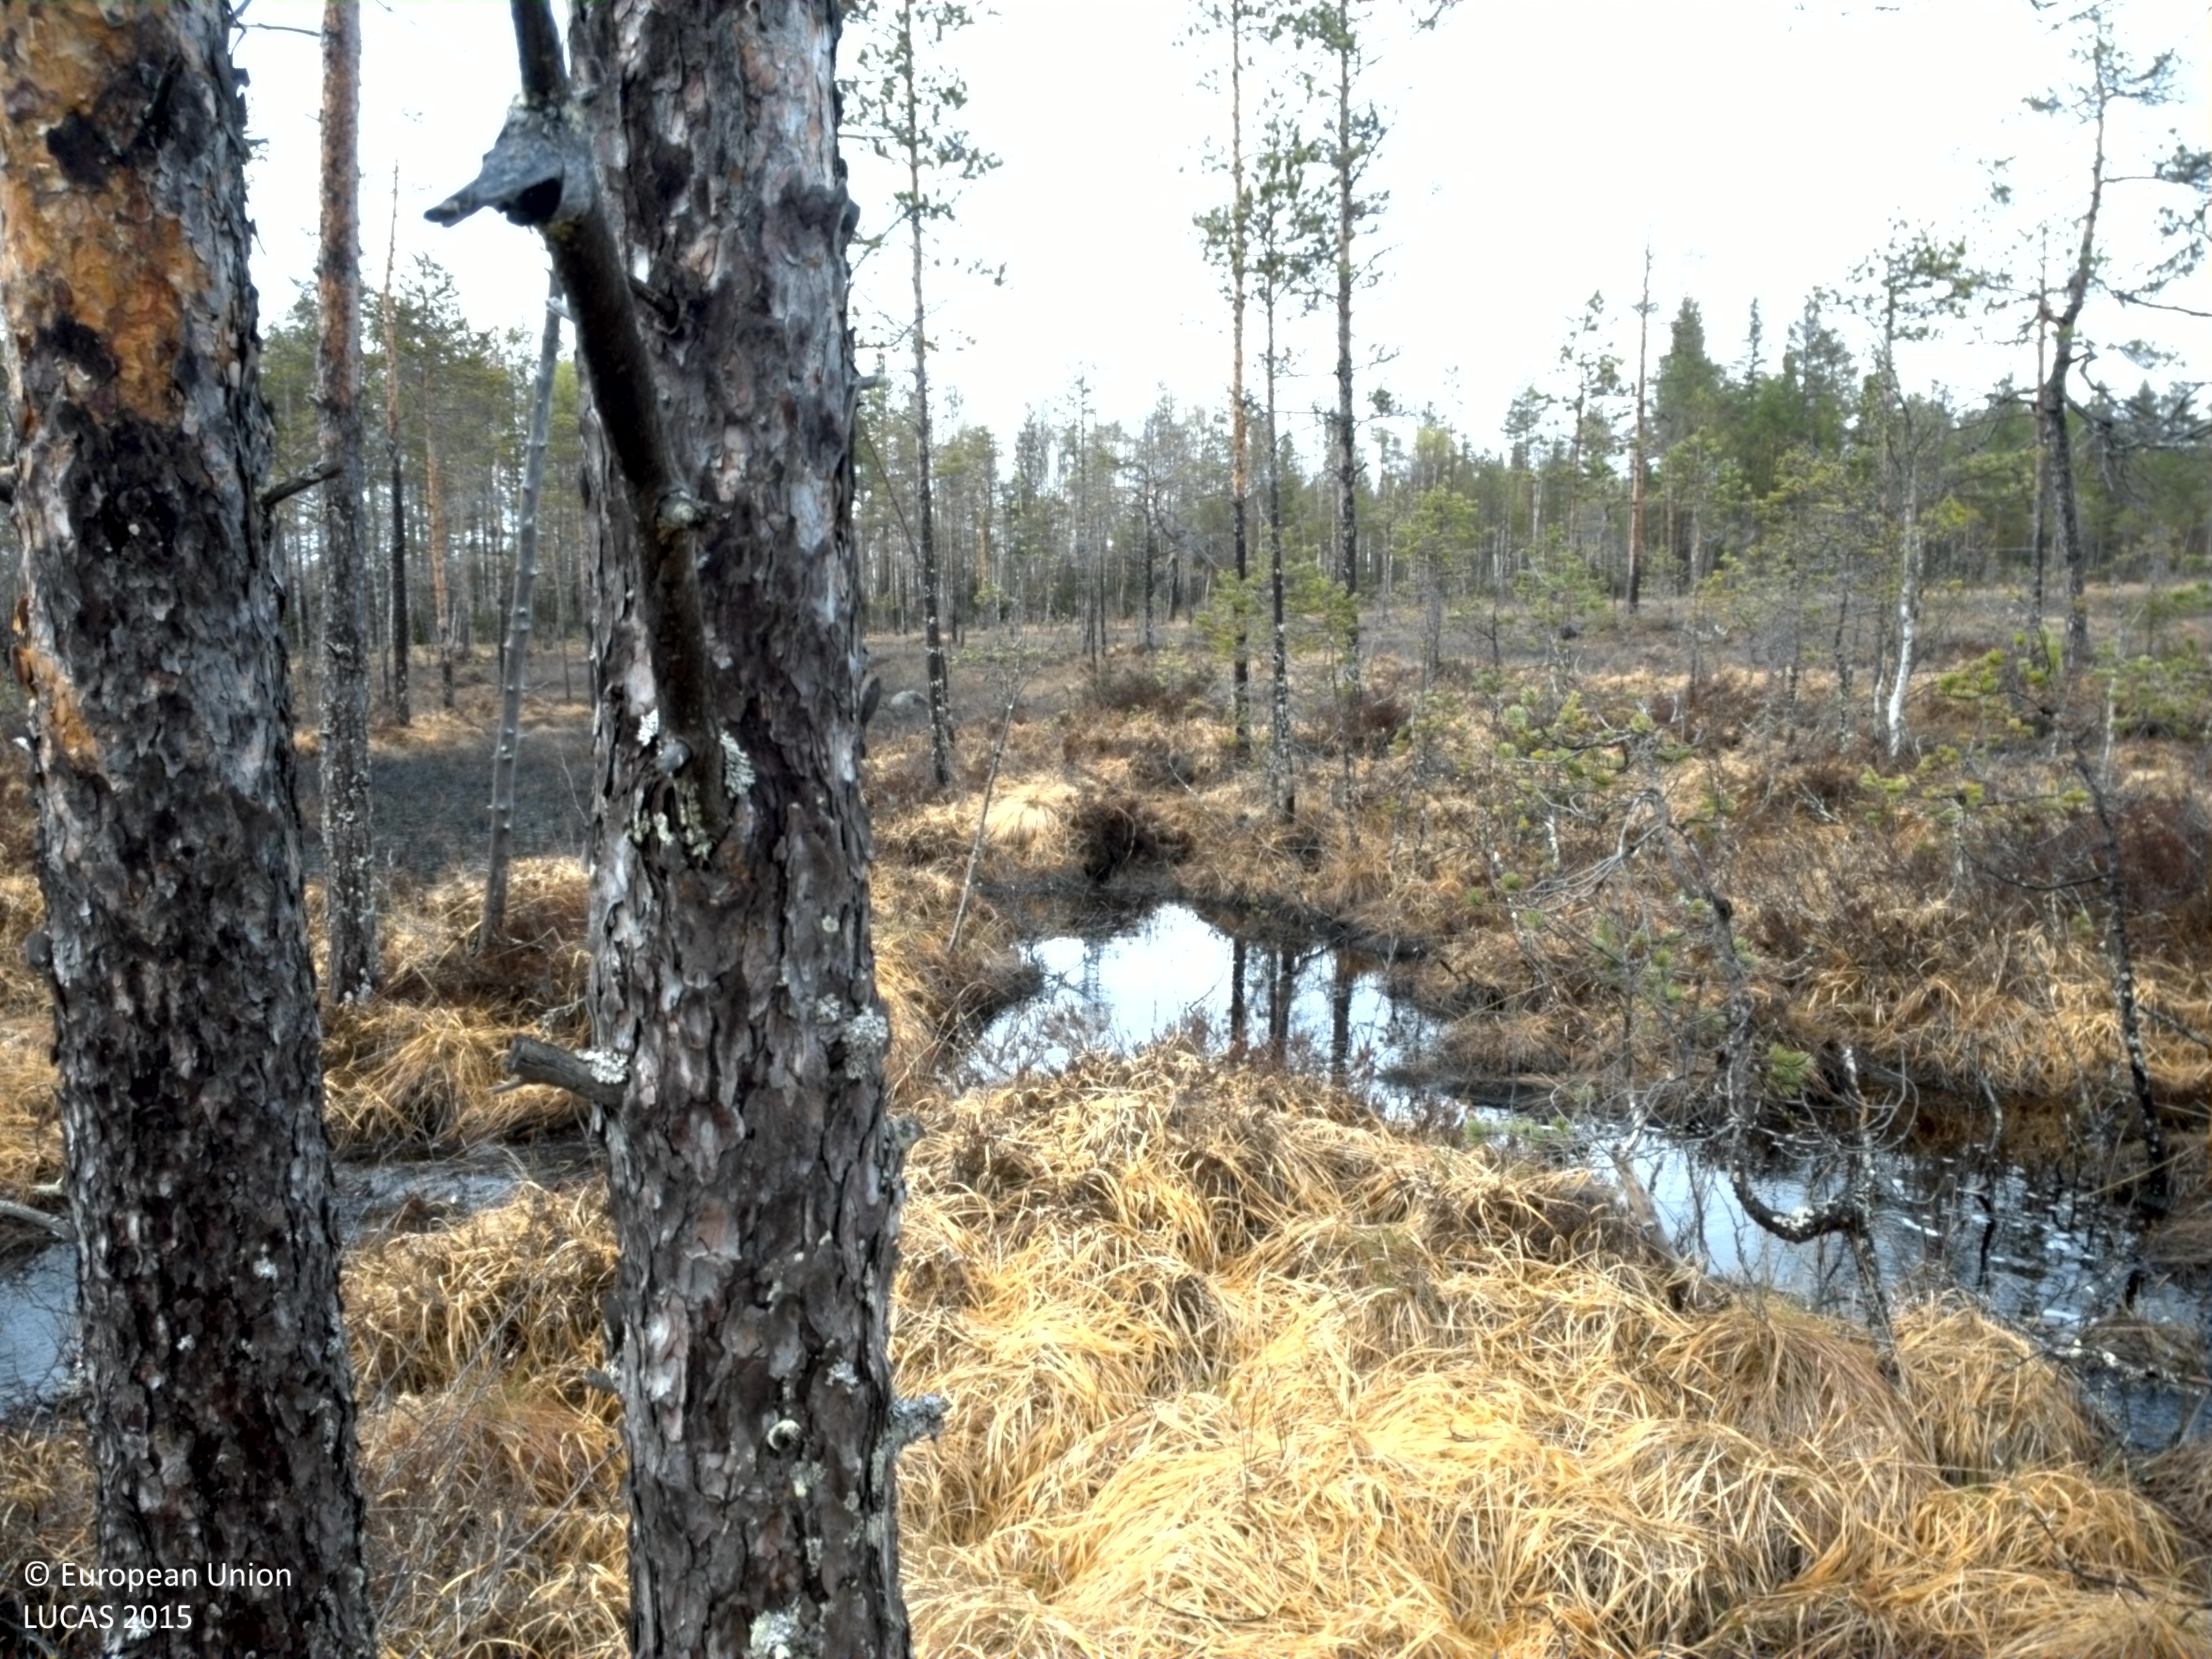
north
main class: Woodland
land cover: Pine dominated coniferous woodland
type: mire and swamp forests
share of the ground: 25 - 50 %
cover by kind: herbaceous plants 45 %, coniferous forest trees 35 %, shrubs 15 %, broadleaved forest trees 5 %
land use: Semi-natural and natural areas not in use
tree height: > 5 m
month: May
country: SE
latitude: 66.2117
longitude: 23.2485
